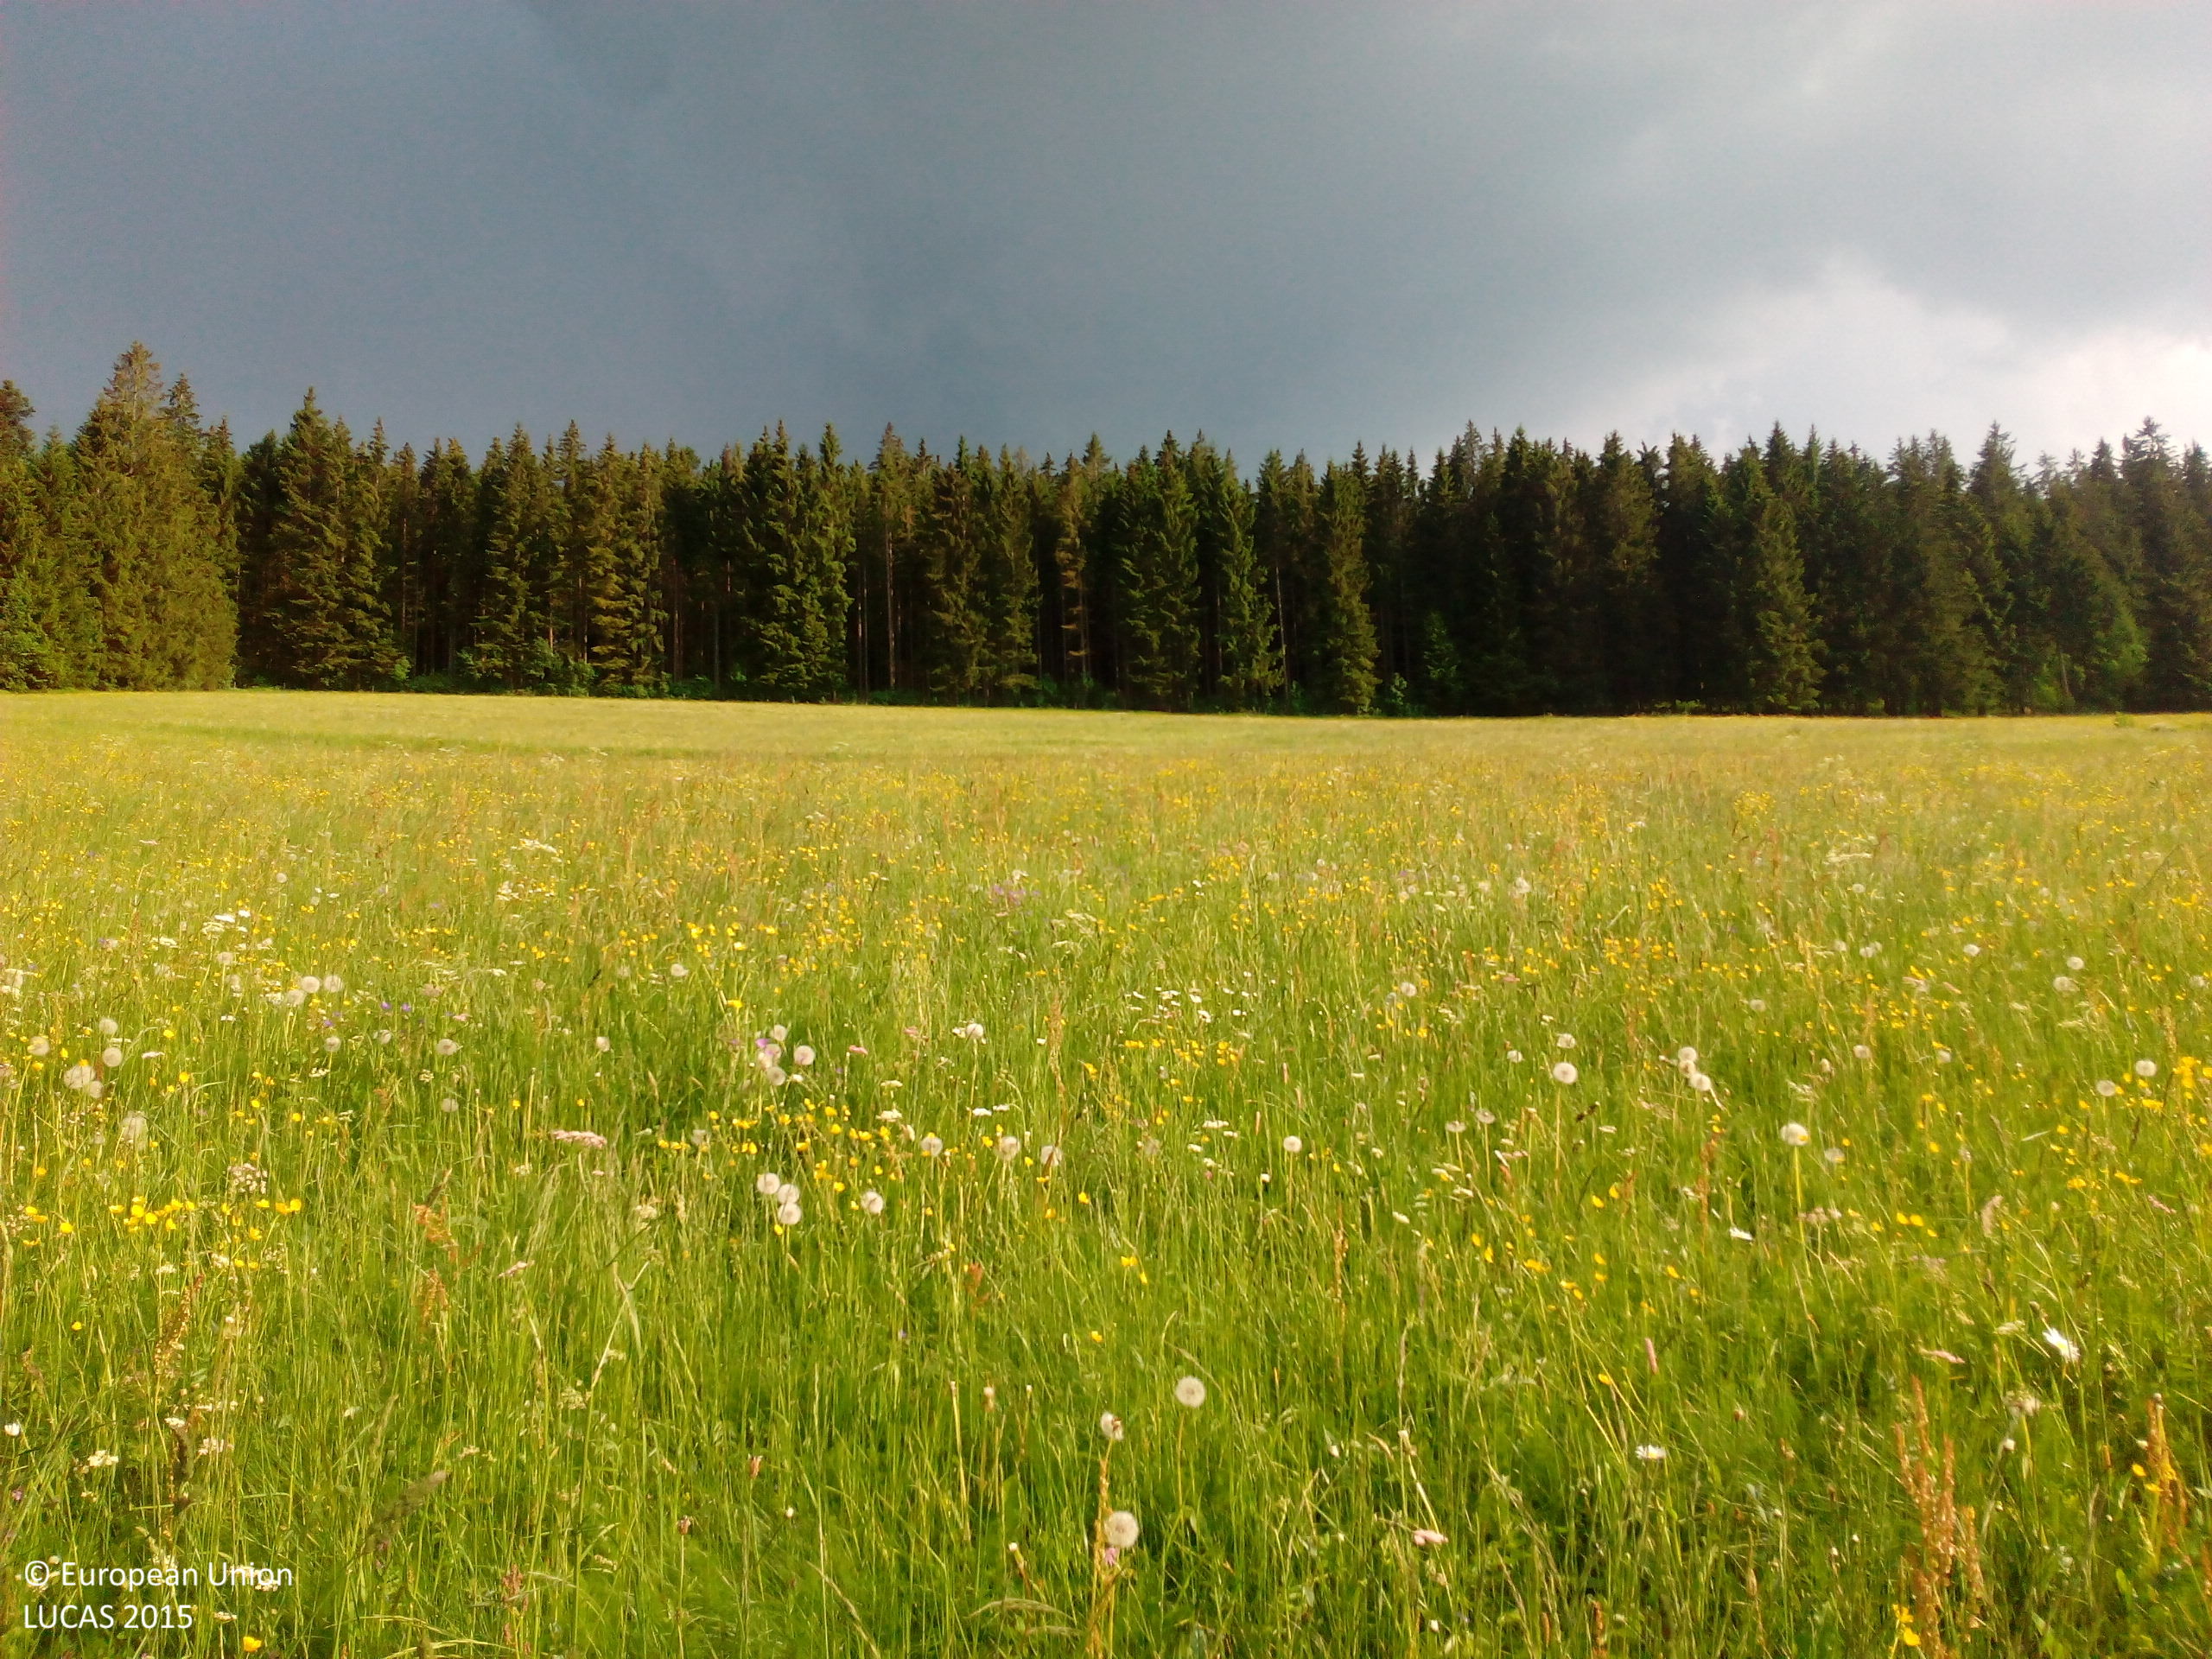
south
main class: Grassland
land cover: Grassland without tree/shrub cover
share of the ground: > 75 %
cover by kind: herbaceous plants 100 %
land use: Agriculture (excluding fallow land and kitchen gardens)
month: June
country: DE
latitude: 47.9558
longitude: 8.1397
